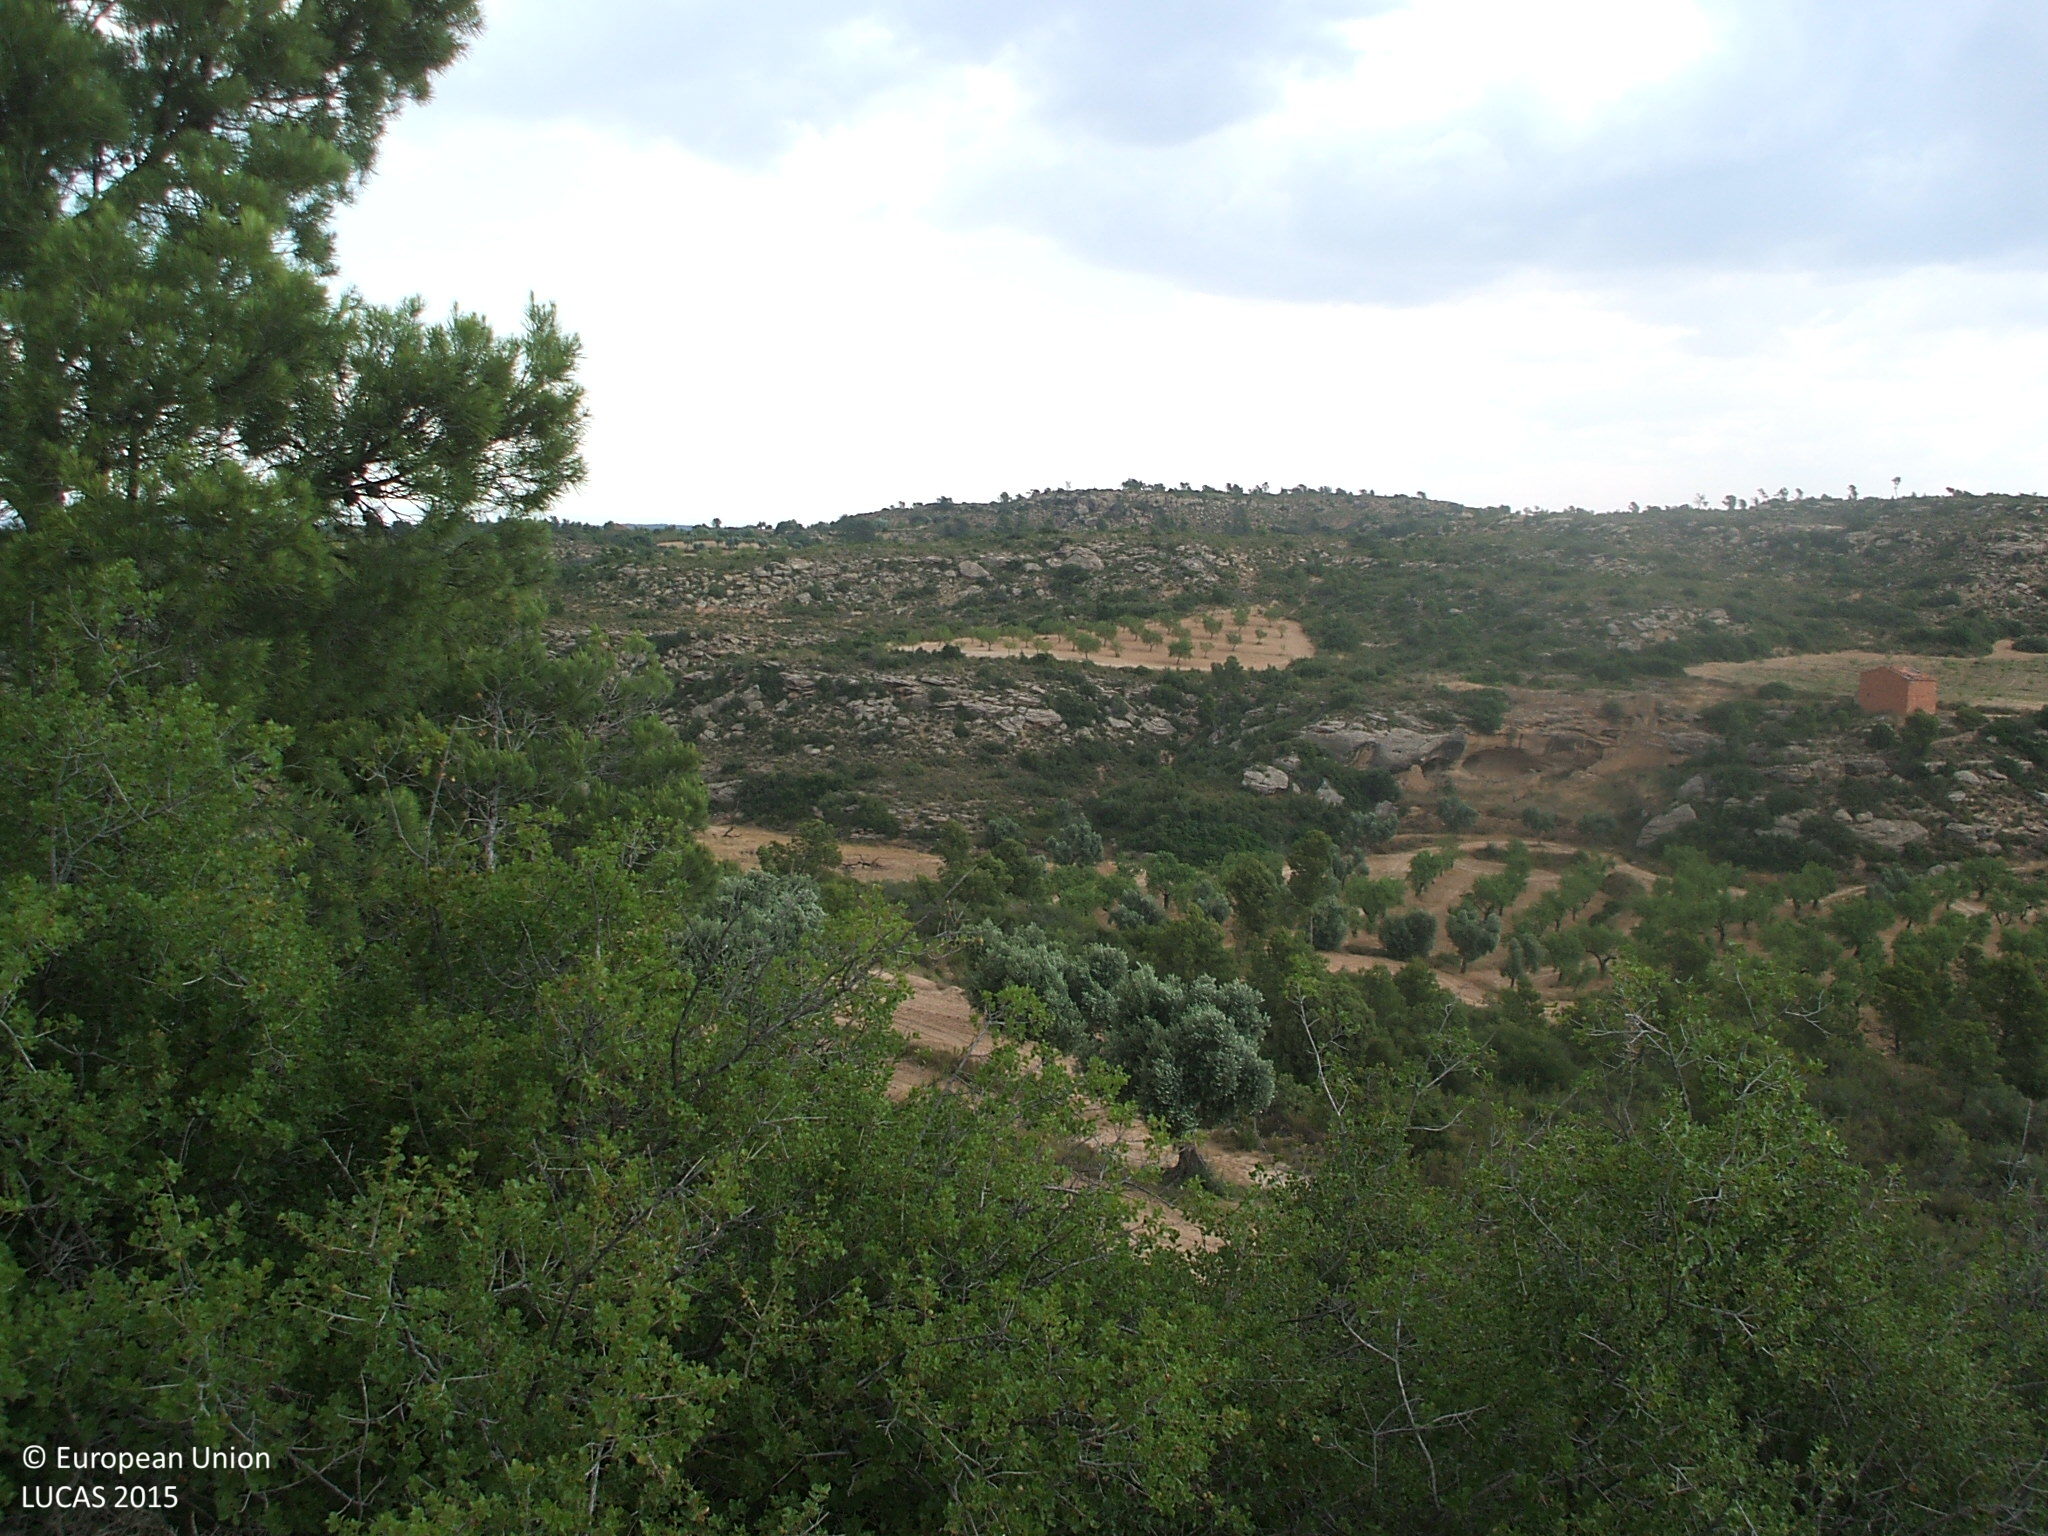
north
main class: Shrubland
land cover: Shrubland with sparse tree cover
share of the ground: > 75 %
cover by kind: shrubs 95 %, coniferous forest trees 5 %
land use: Semi-natural and natural areas not in use
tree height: > 5 m
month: June
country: ES
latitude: 41.0286
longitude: -0.0131
